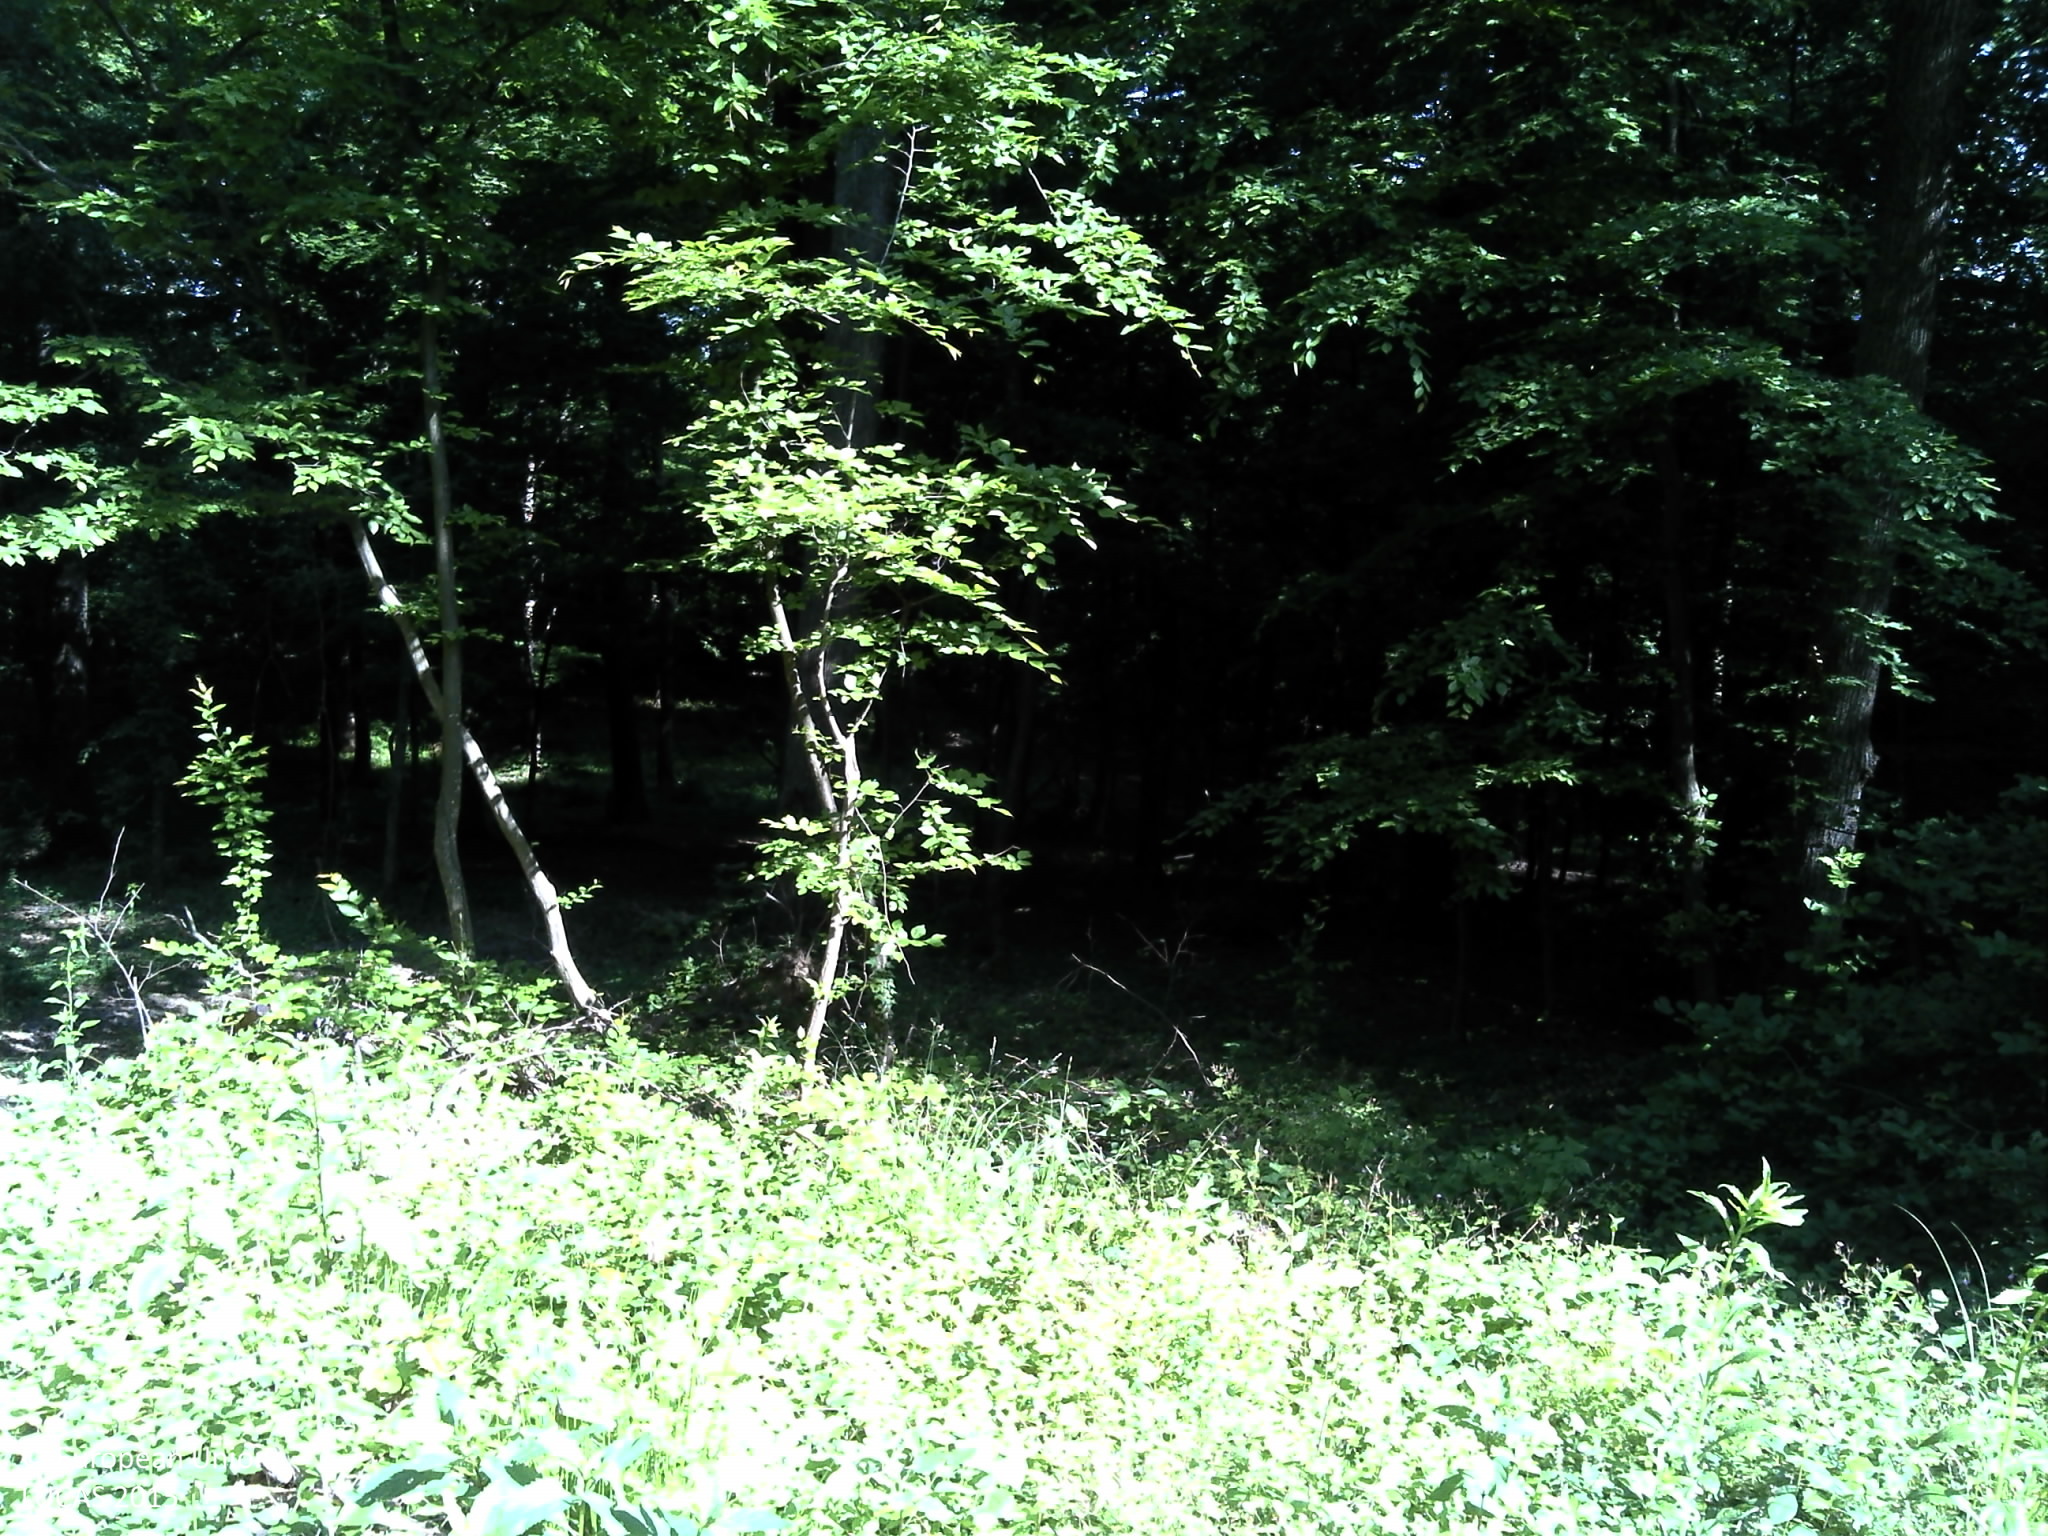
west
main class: Woodland
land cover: Broadleaved woodland
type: acidophilous oak and oak-birch forest
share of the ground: > 75 %
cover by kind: broadleaved forest trees 100 %
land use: Forestry
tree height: > 5 m
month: May
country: HR
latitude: 45.4882
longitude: 18.0263
